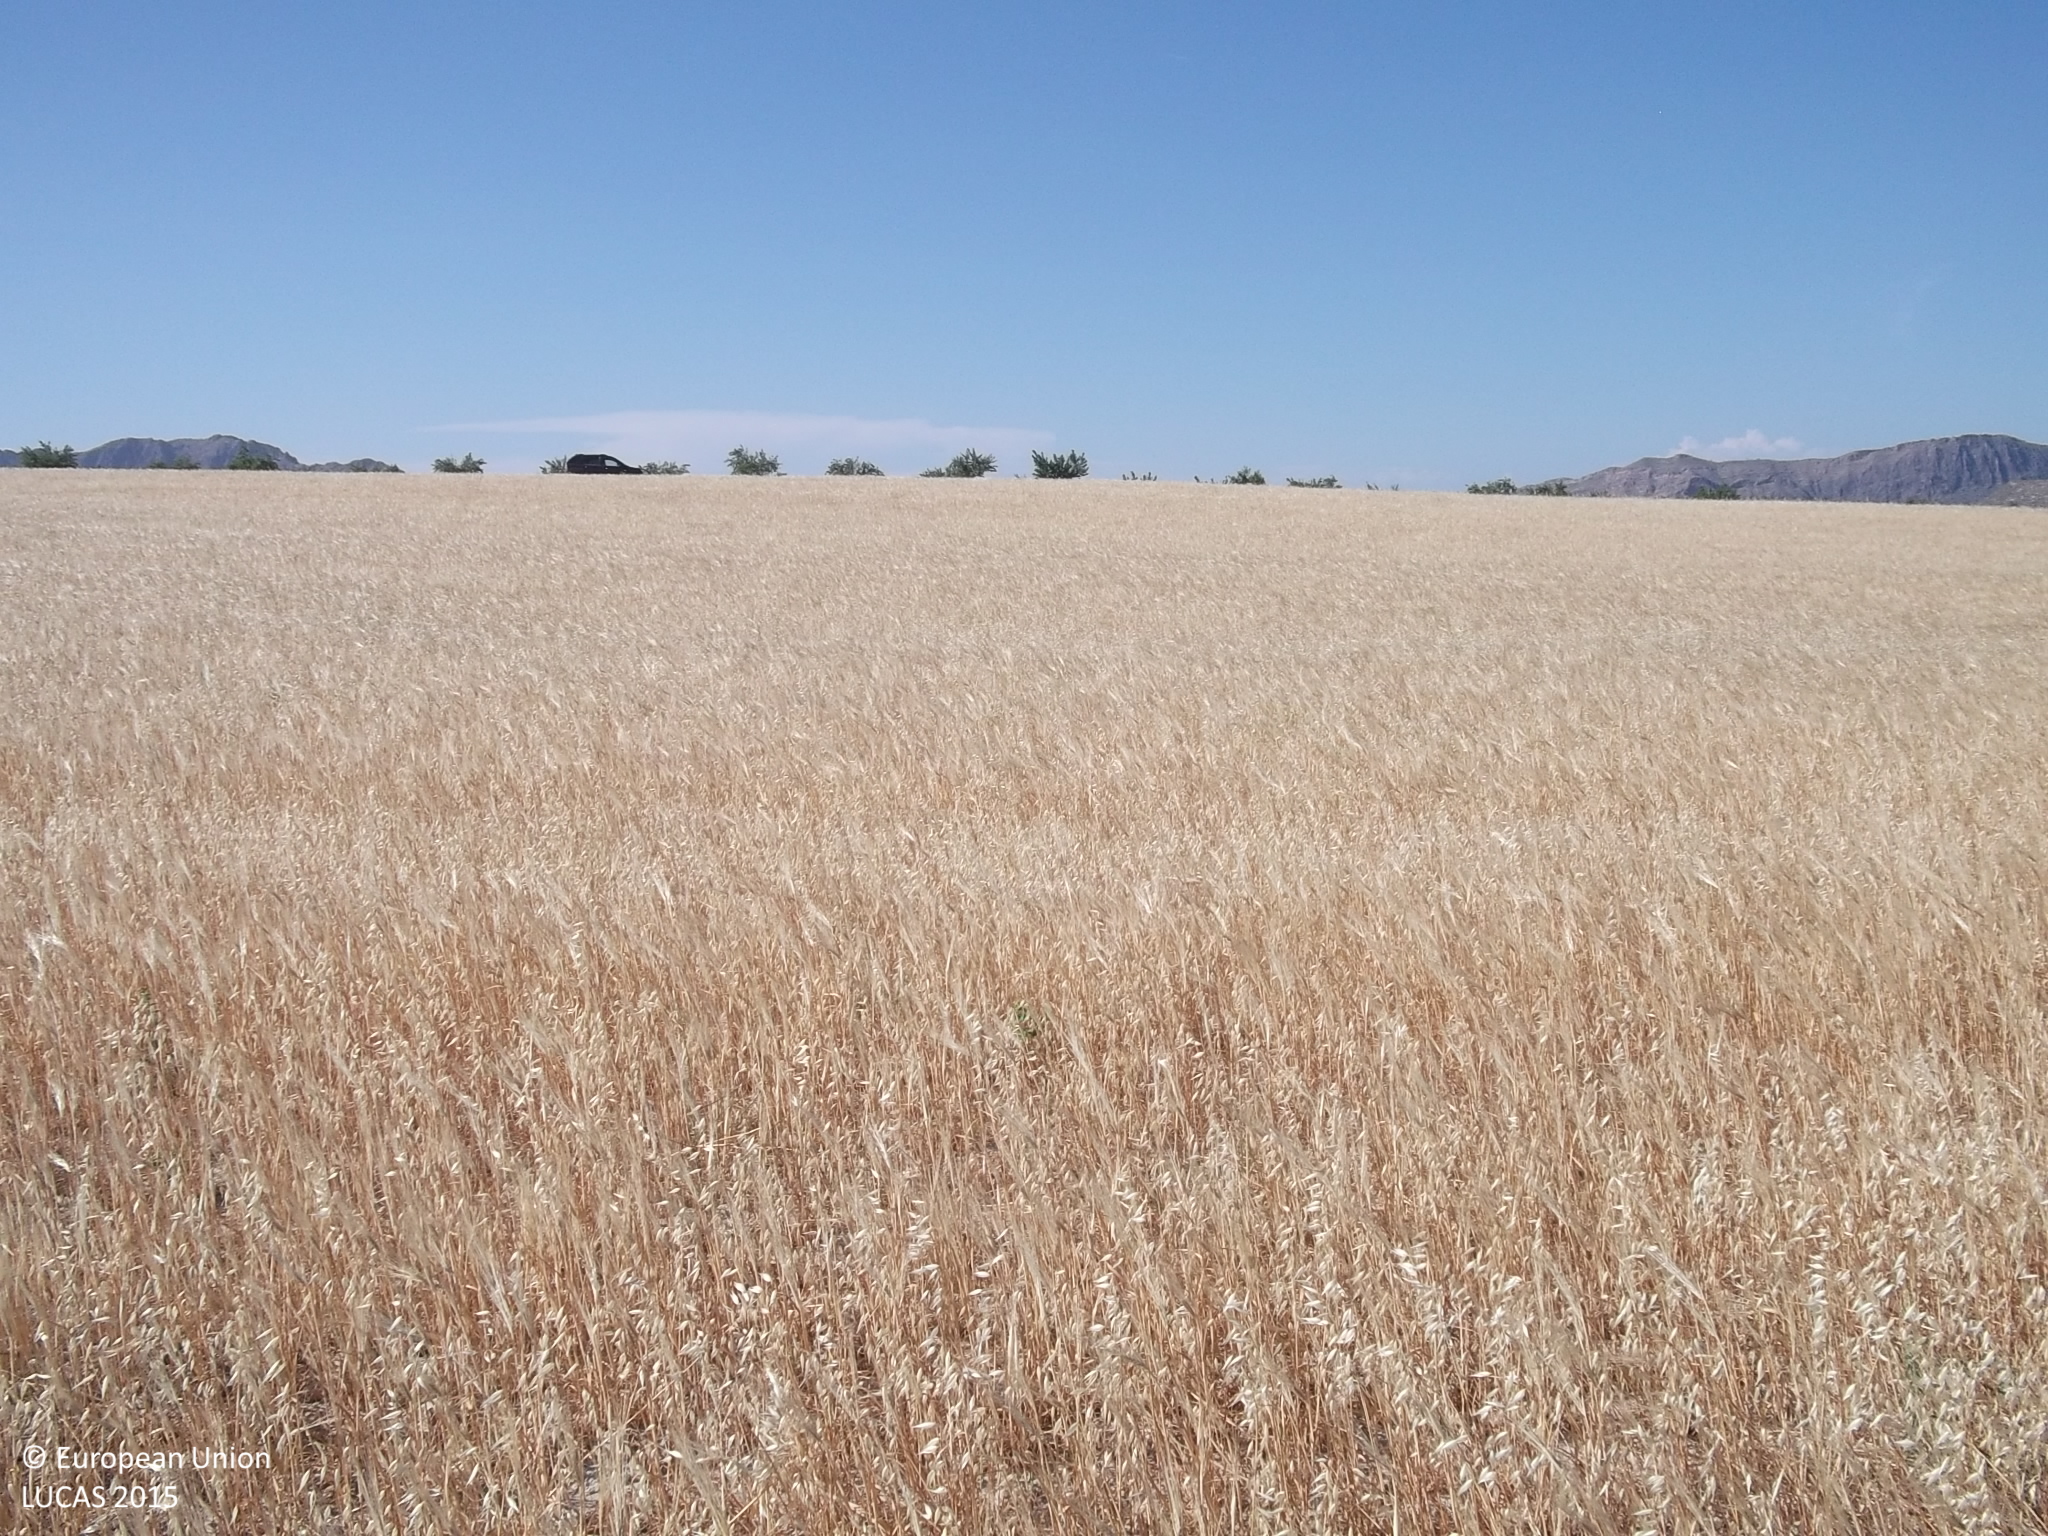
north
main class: Cropland
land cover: Barley
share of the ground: > 75 %
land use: Agriculture (excluding fallow land and kitchen gardens)
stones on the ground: < 10 %
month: June
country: ES
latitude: 38.1672
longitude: -1.6194
